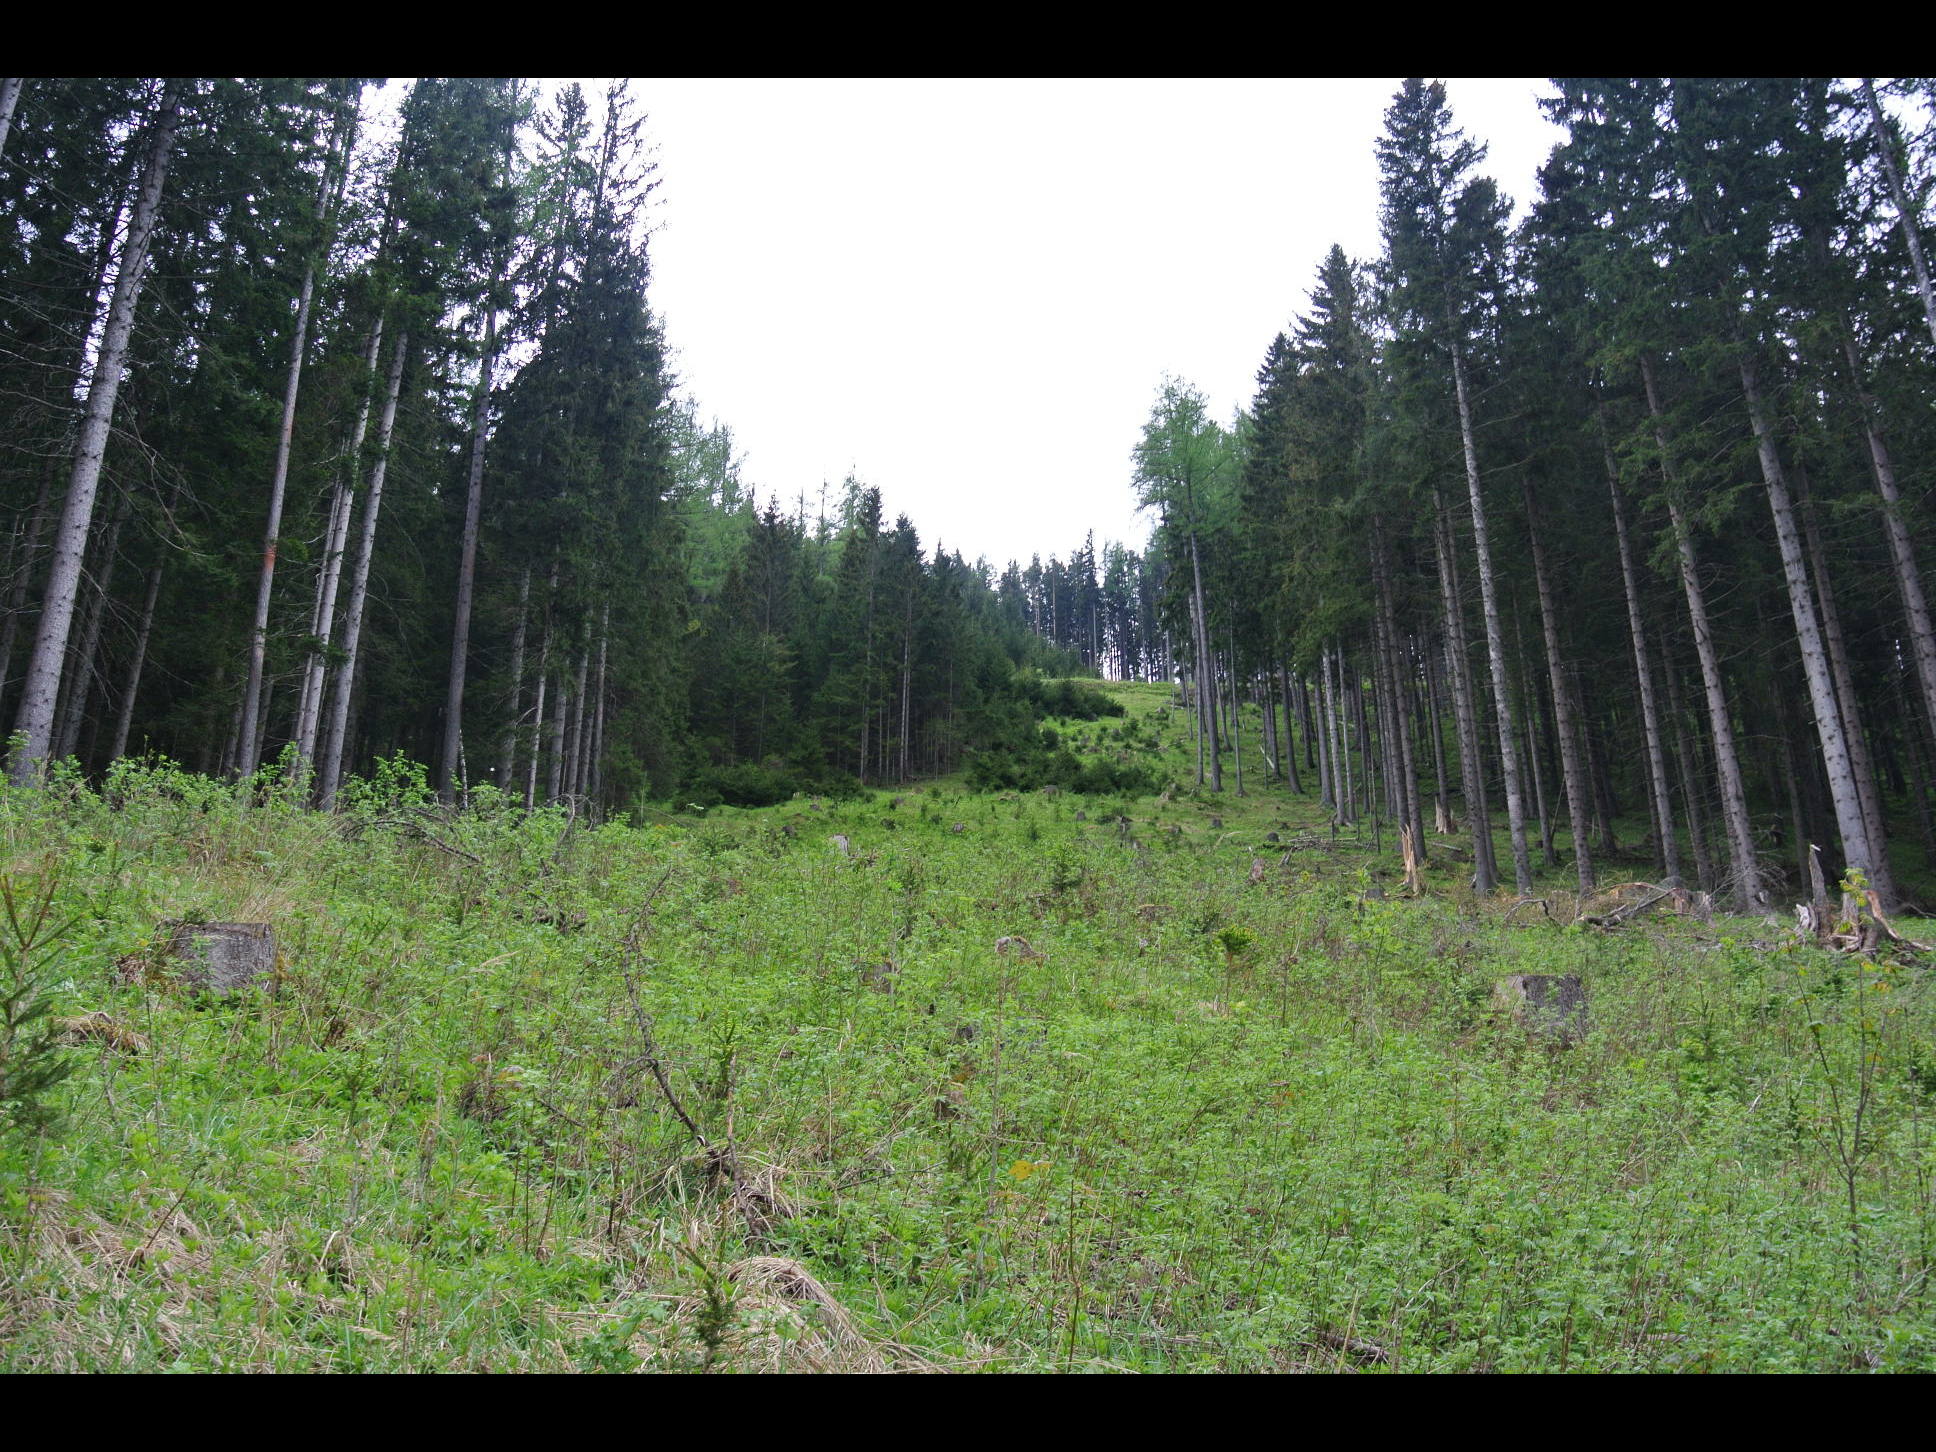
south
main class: Shrubland
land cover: Shrubland with sparse tree cover
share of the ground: > 75 %
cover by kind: shrubs 75 %, herbaceous plants 20 %, broadleaved forest trees 5 %
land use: Forestry
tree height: < 5 m
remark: Clear cut
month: May
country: AT
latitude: 47.6604
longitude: 15.7142
